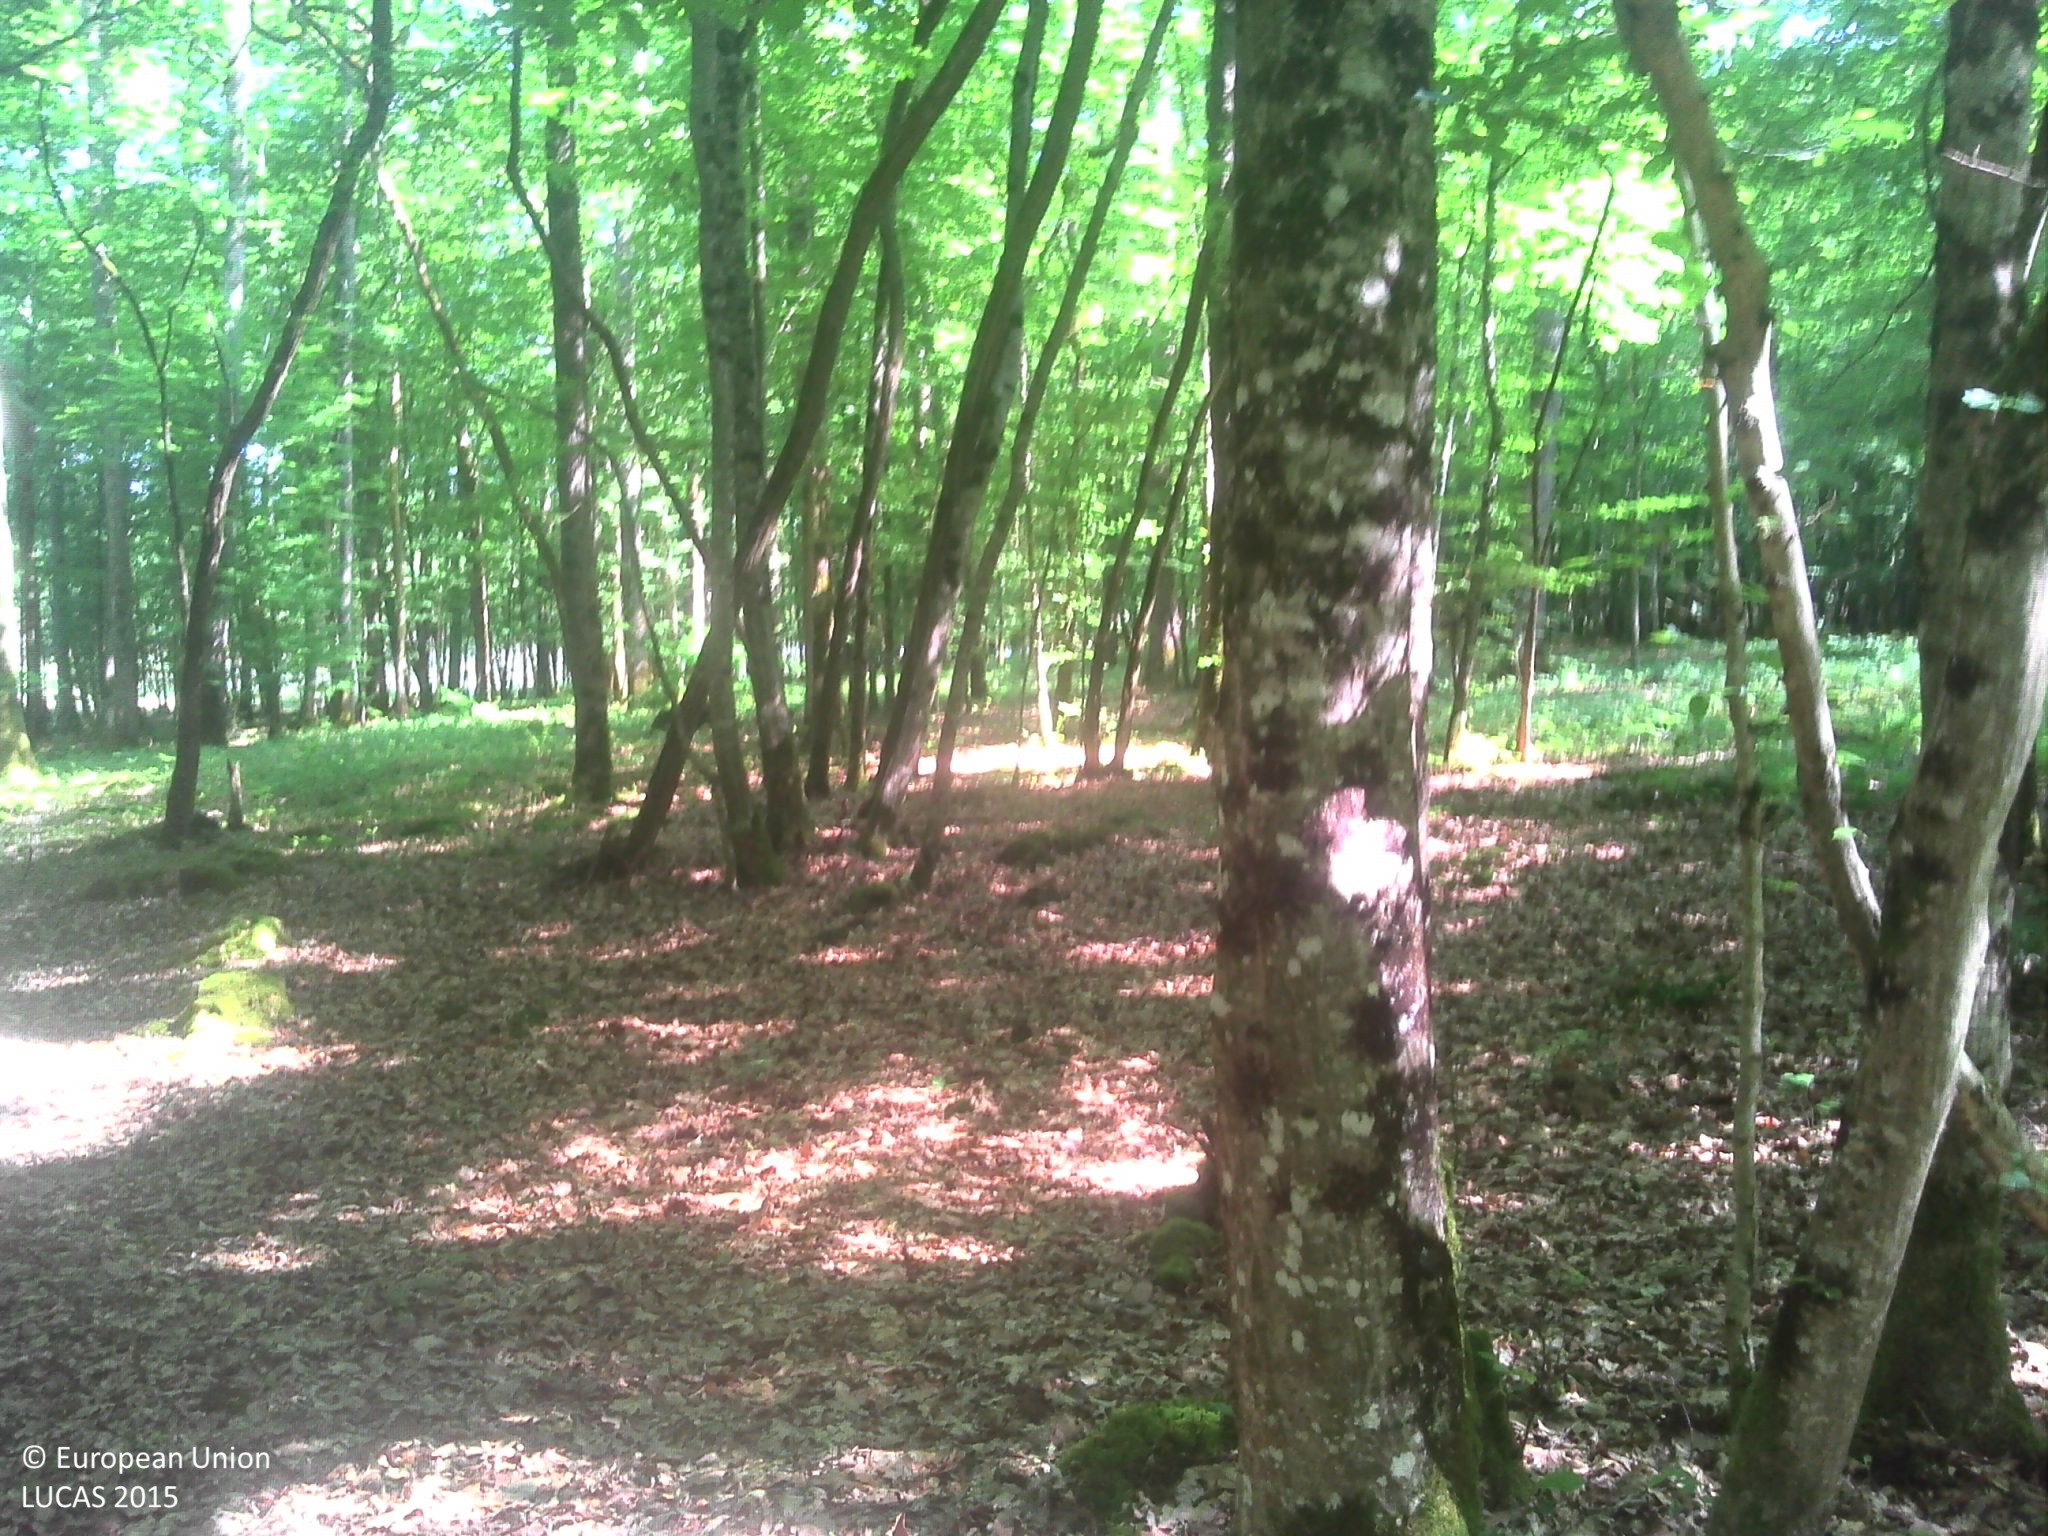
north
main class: Woodland
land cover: Broadleaved woodland
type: acidophilous oak and oak-birch forest
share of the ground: > 75 %
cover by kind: broadleaved forest trees 85 %, herbaceous plants 10 %, coniferous forest trees 5 %
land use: Forestry
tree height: > 5 m
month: June
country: FR
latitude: 48.4034
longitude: 4.7163
